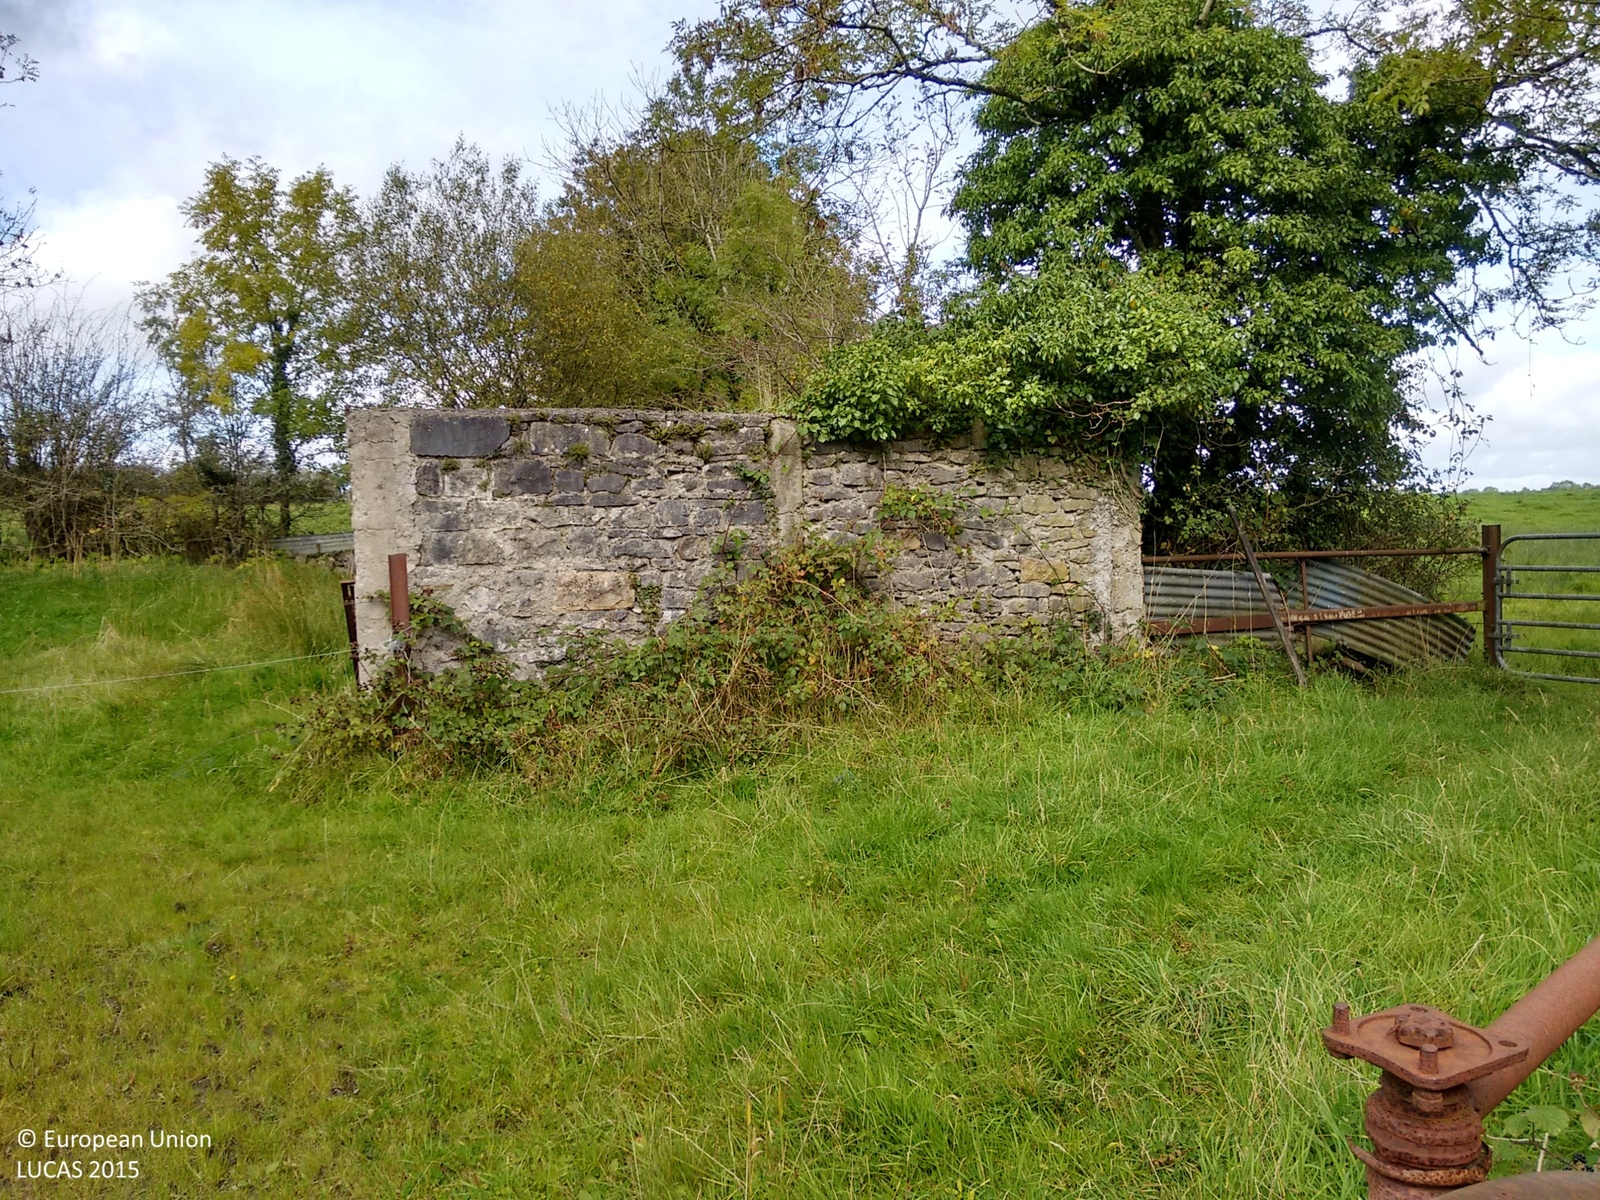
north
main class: Grassland
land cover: Grassland without tree/shrub cover
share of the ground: > 75 %
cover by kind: herbaceous plants 100 %
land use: Agriculture (excluding fallow land and kitchen gardens)
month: October
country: IE
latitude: 53.7833
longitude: -8.1651
